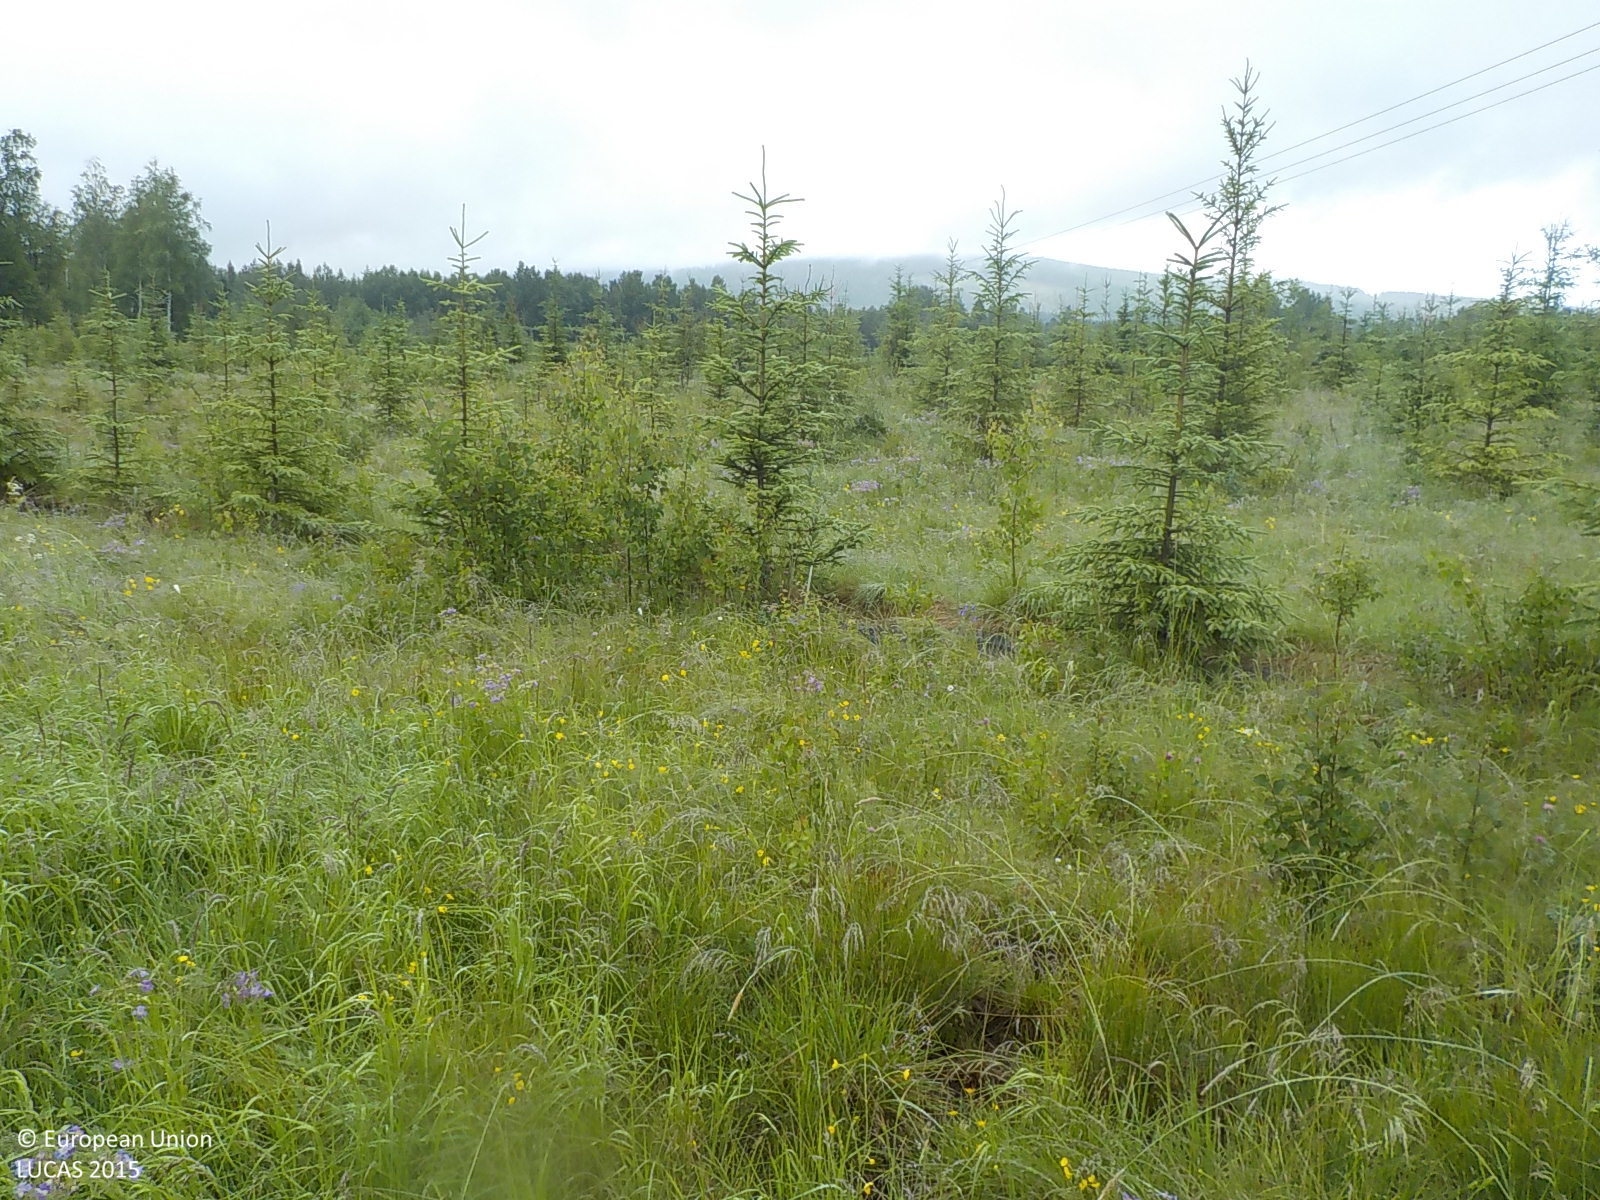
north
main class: Woodland
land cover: Spruce dominated coniferous woodland
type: boreal forest
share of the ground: 50 - 75 %
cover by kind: coniferous forest trees 50 %, herbaceous plants 50 %
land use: Forestry
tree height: < 5 m
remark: Nursery
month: July
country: SE
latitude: 63.1729
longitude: 17.0264
